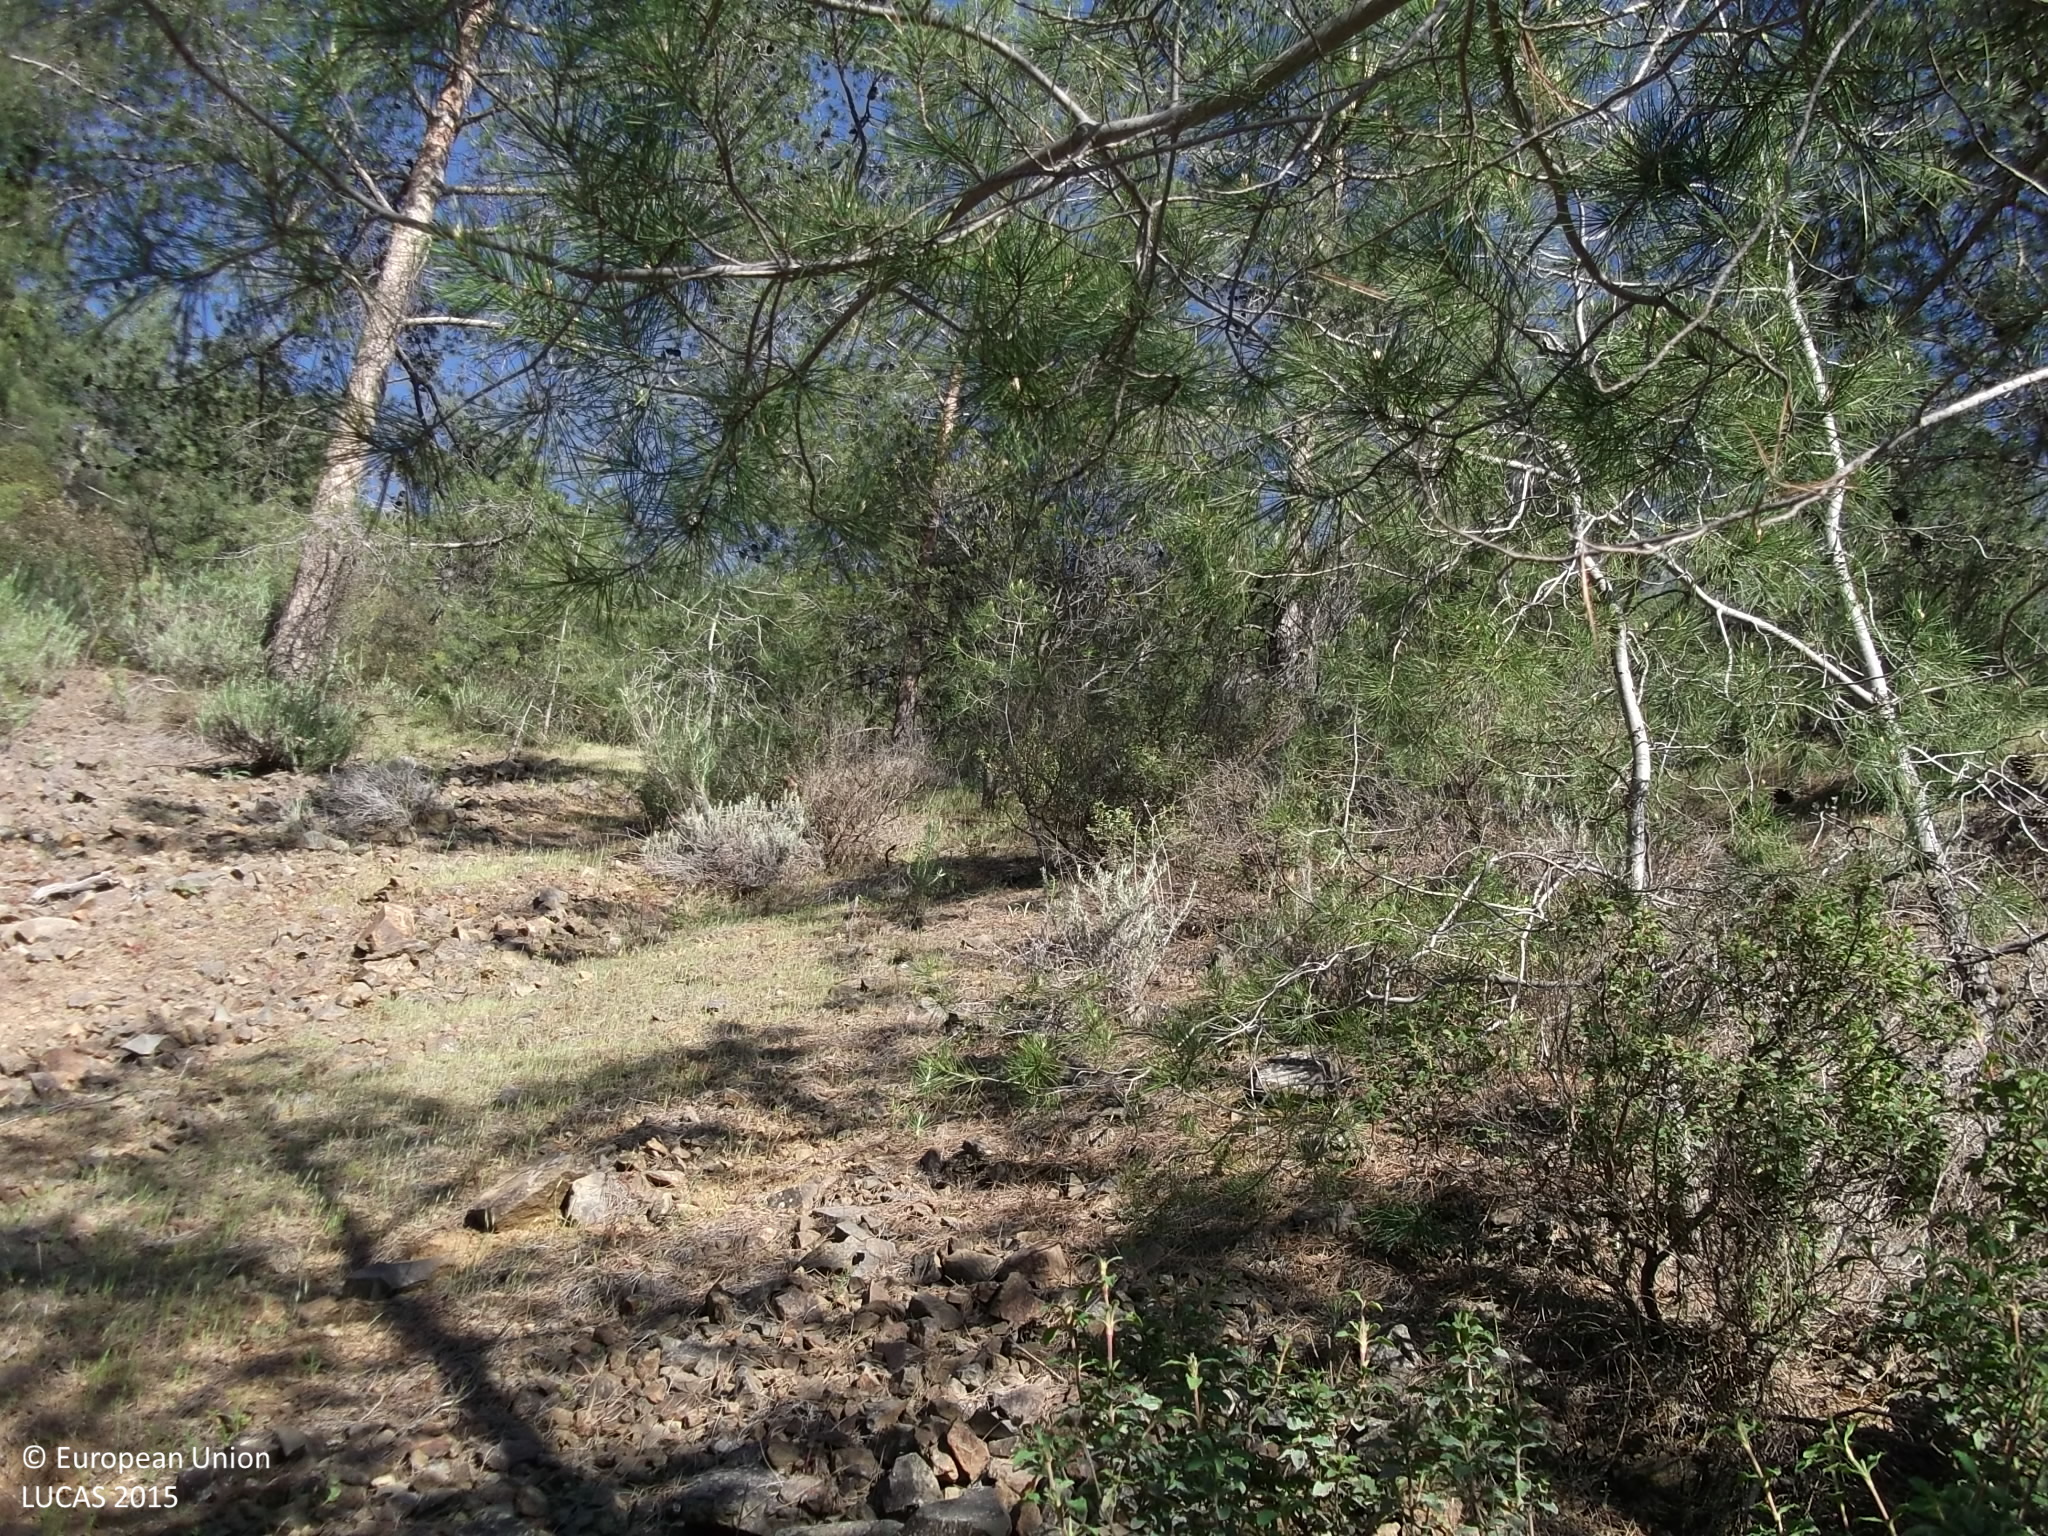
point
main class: Woodland
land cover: Pine dominated coniferous woodland
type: coniferous forest of the mediterranean region
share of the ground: 50 - 75 %
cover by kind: coniferous forest trees 55 %, shrubs 15 %, herbaceous plants 10 %, consolidated bare surface 10 %, unconsolidated bare surface 10 %
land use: Semi-natural and natural areas not in use
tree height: > 5 m
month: April
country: CY
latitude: 34.9287
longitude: 33.1331
